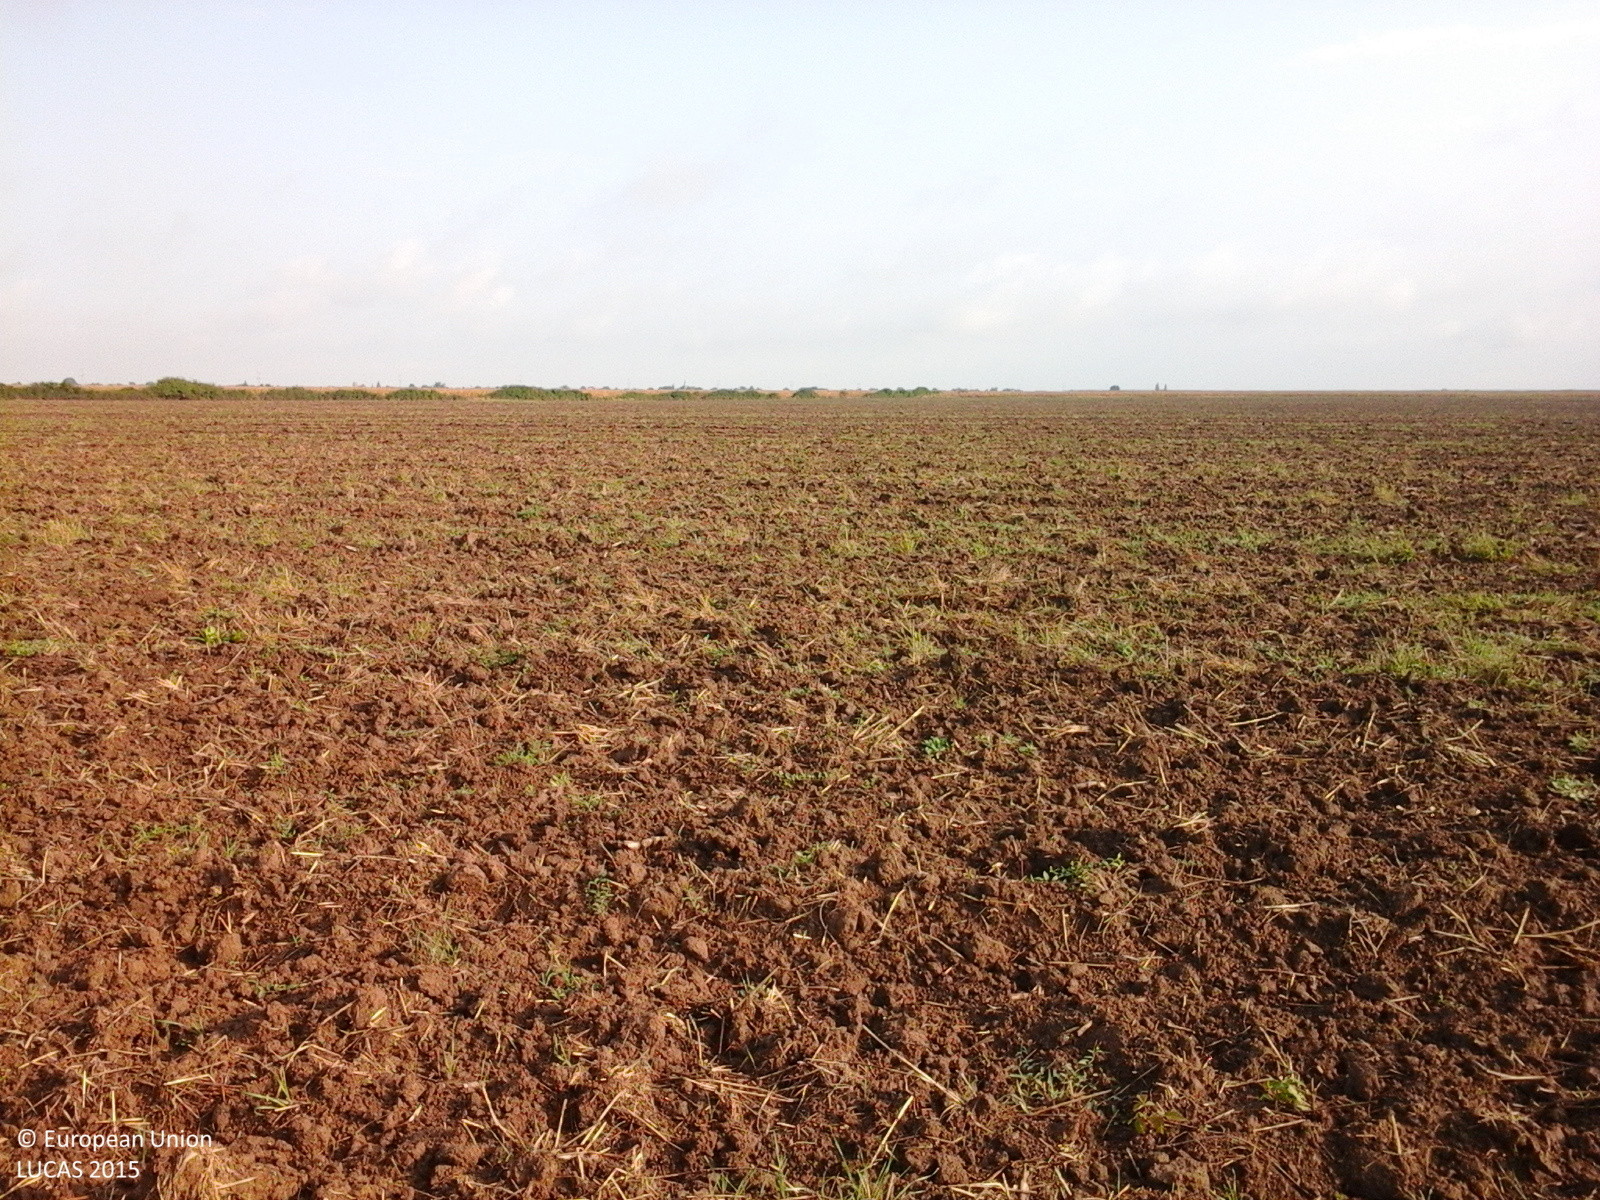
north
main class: Cropland
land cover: Common wheat
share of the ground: < 10 %
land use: Agriculture (excluding fallow land and kitchen gardens)
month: September
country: RO
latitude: 46.8113
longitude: 21.7455
